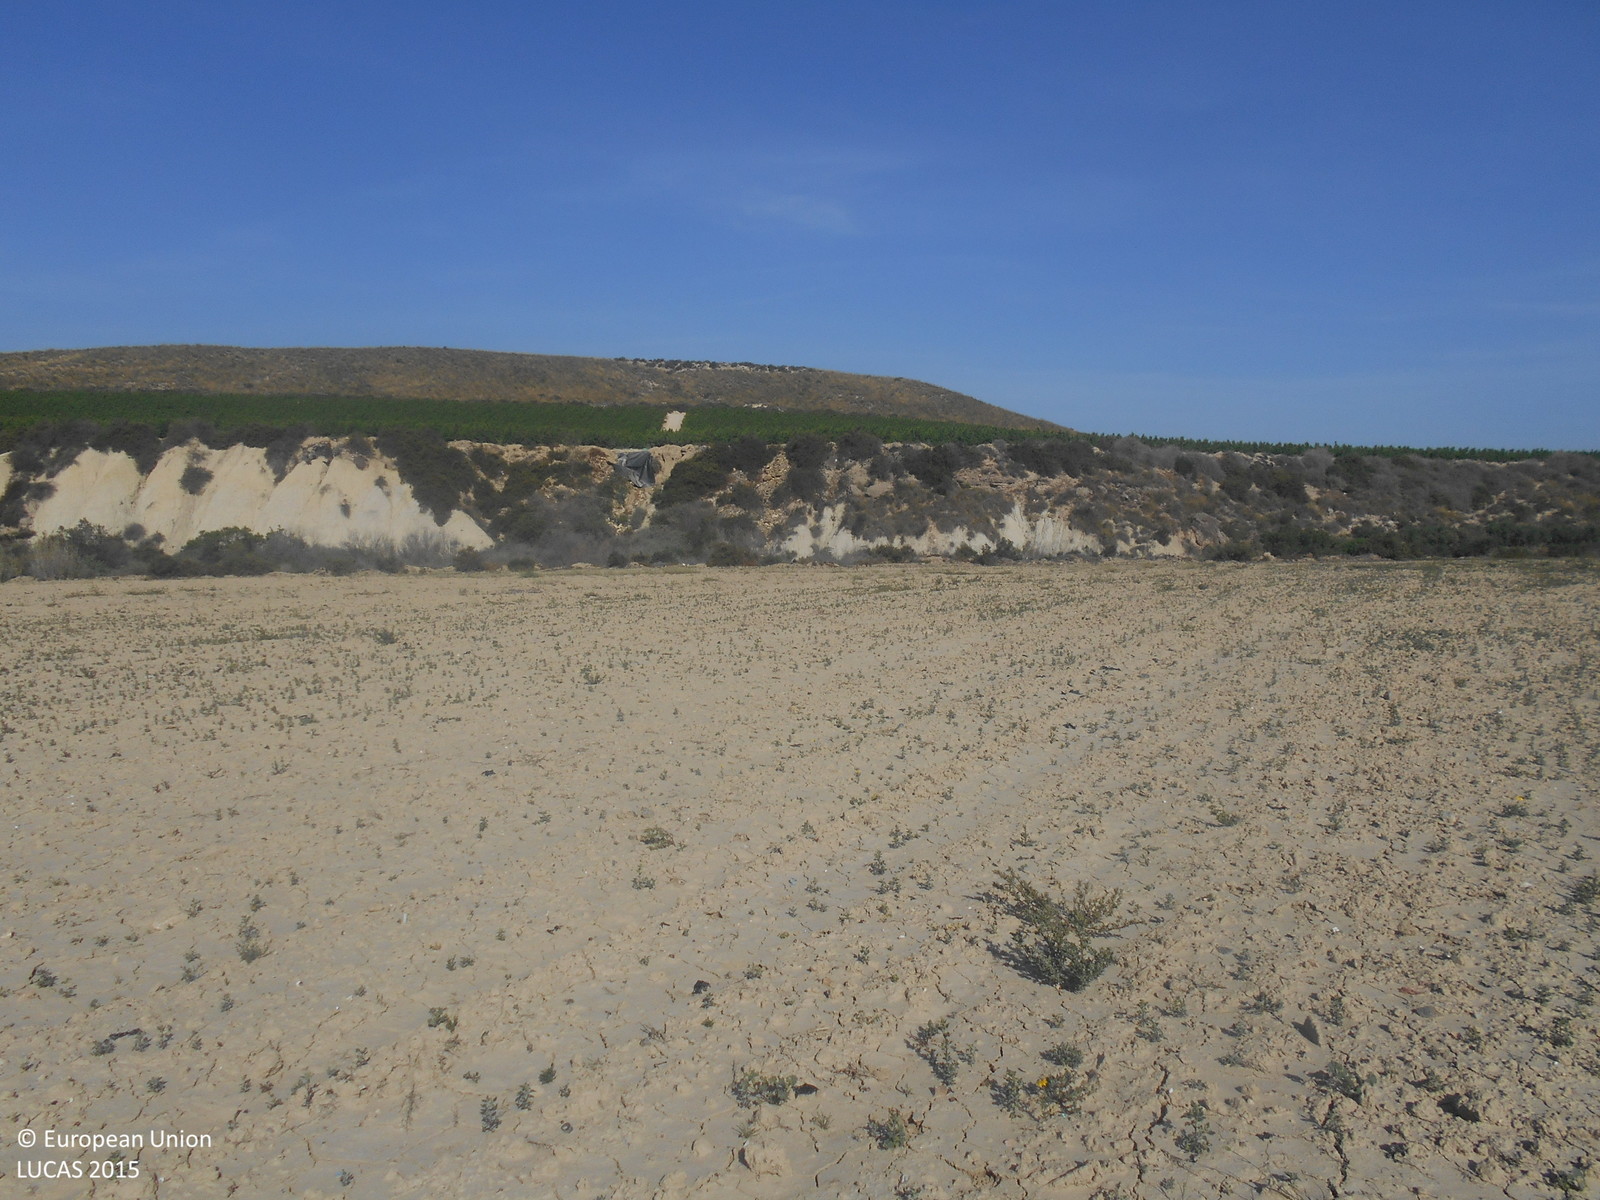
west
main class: Grassland
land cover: Spontaneously vegetated surfaces
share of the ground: 10 - 25 %
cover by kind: unconsolidated bare surface 80 %, herbaceous plants 20 %
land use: Fallow land
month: May
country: ES
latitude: 37.6638
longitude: -1.3967
